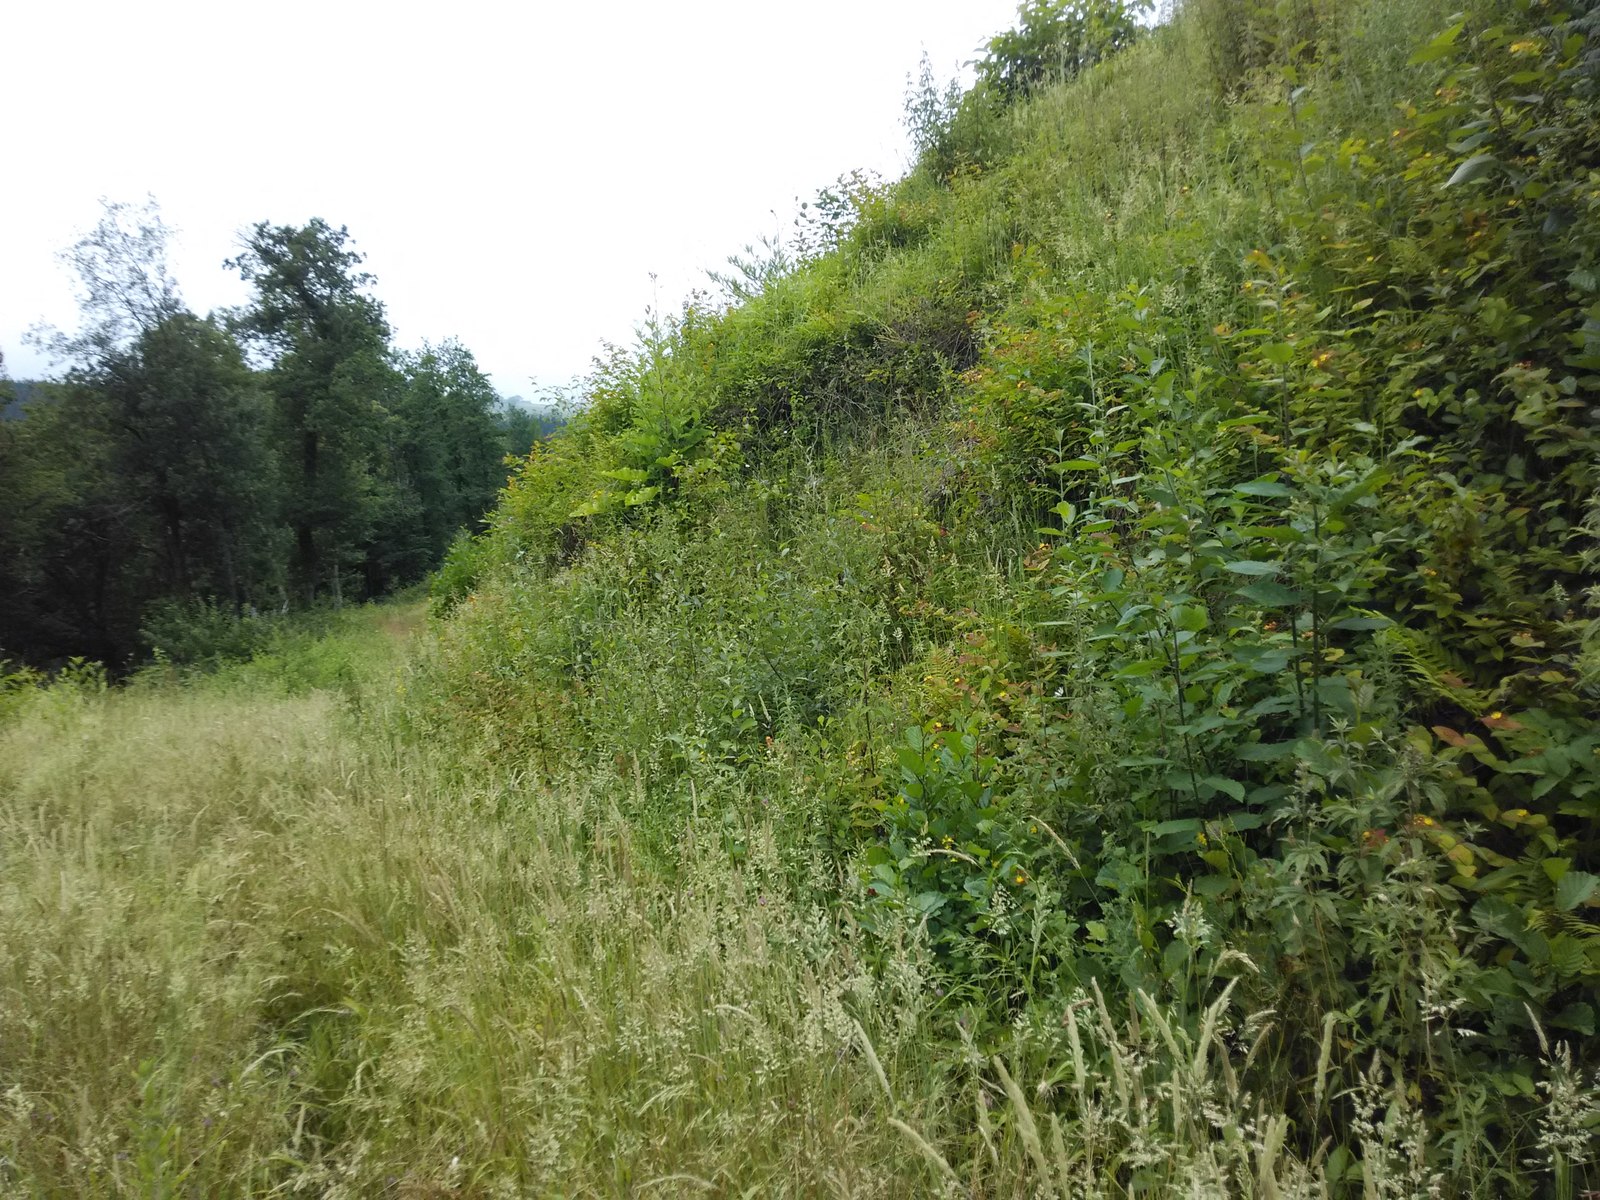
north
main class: Woodland
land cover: Broadleaved woodland
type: floodplain forest
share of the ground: > 75 %
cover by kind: broadleaved forest trees 85 %, coniferous forest trees 10 %, unconsolidated bare surface 5 %
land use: Forestry
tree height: > 5 m
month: July
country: ES
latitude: 43.0934
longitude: -2.2477
